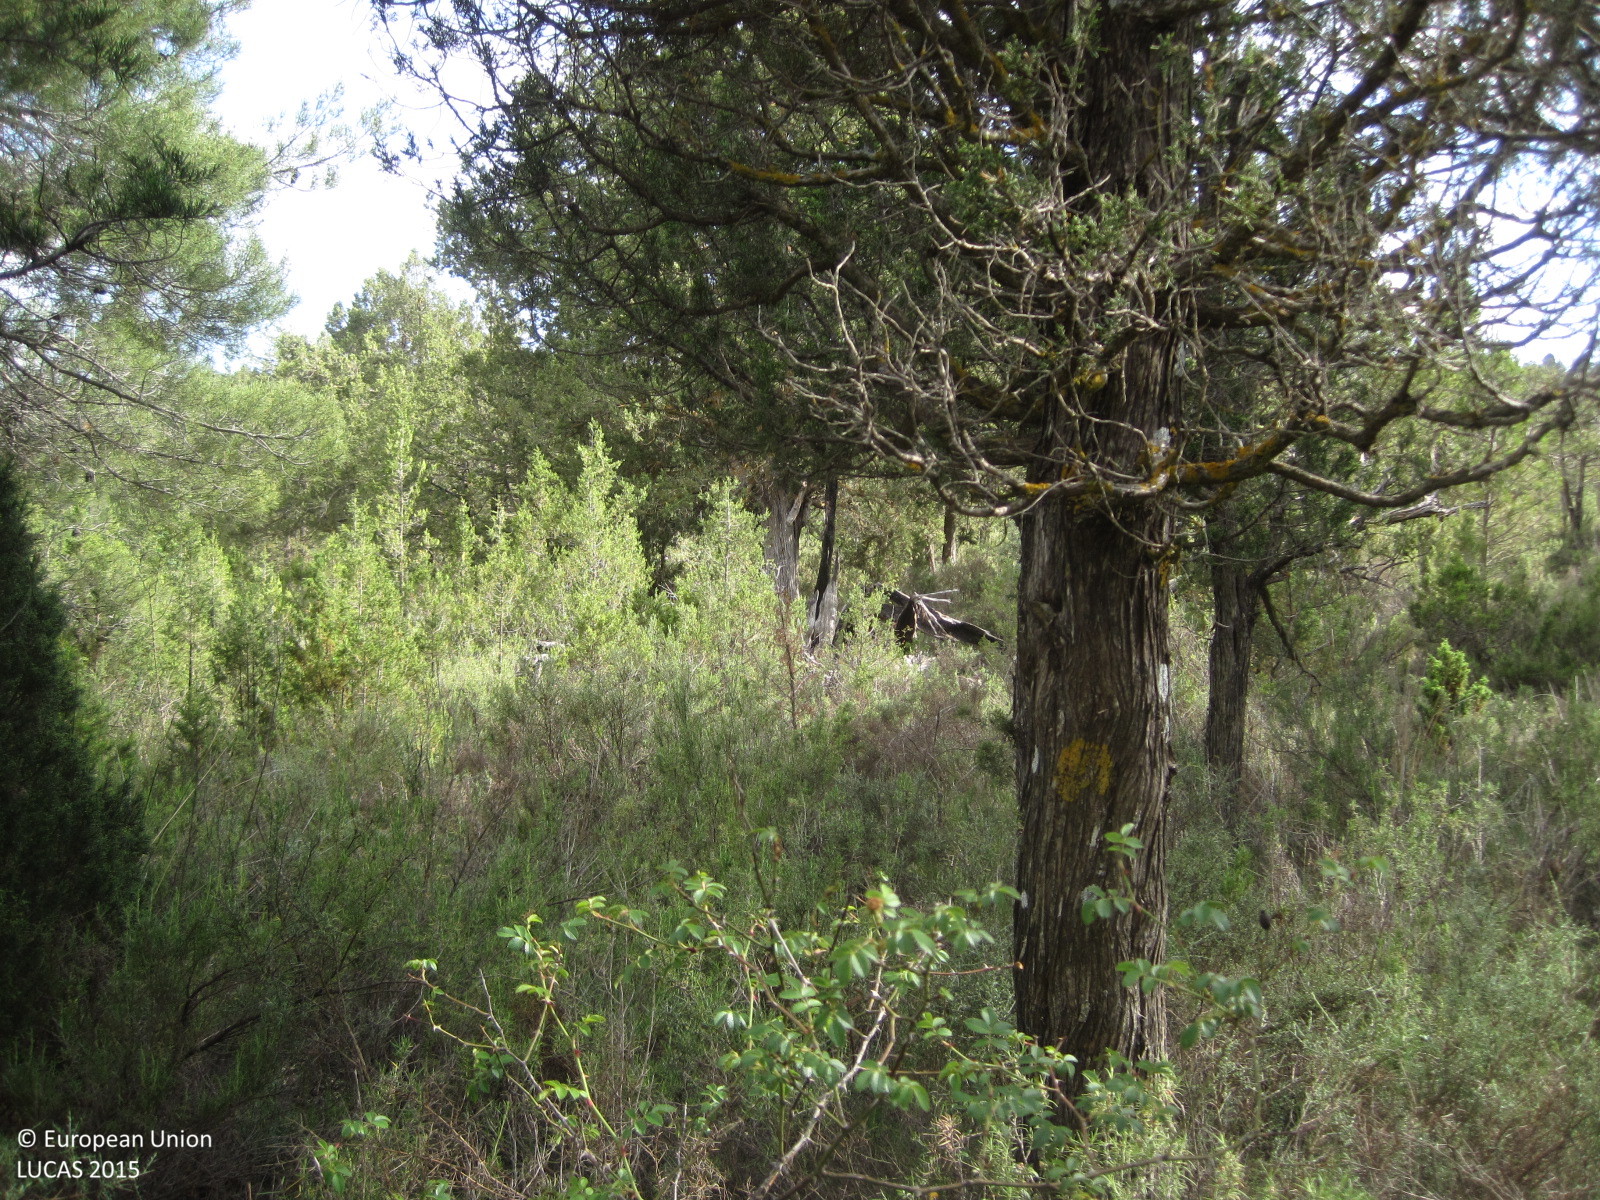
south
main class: Woodland
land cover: Other coniferous woodland
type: coniferous forest of the mediterranean region
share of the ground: 50 - 75 %
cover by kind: coniferous forest trees 55 %, shrubs 25 %, herbaceous plants 15 %, lichens and mosses 5 %
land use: Forestry
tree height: > 5 m
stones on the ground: 25 - 50 %
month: June
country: ES
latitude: 39.9573
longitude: -0.9977
